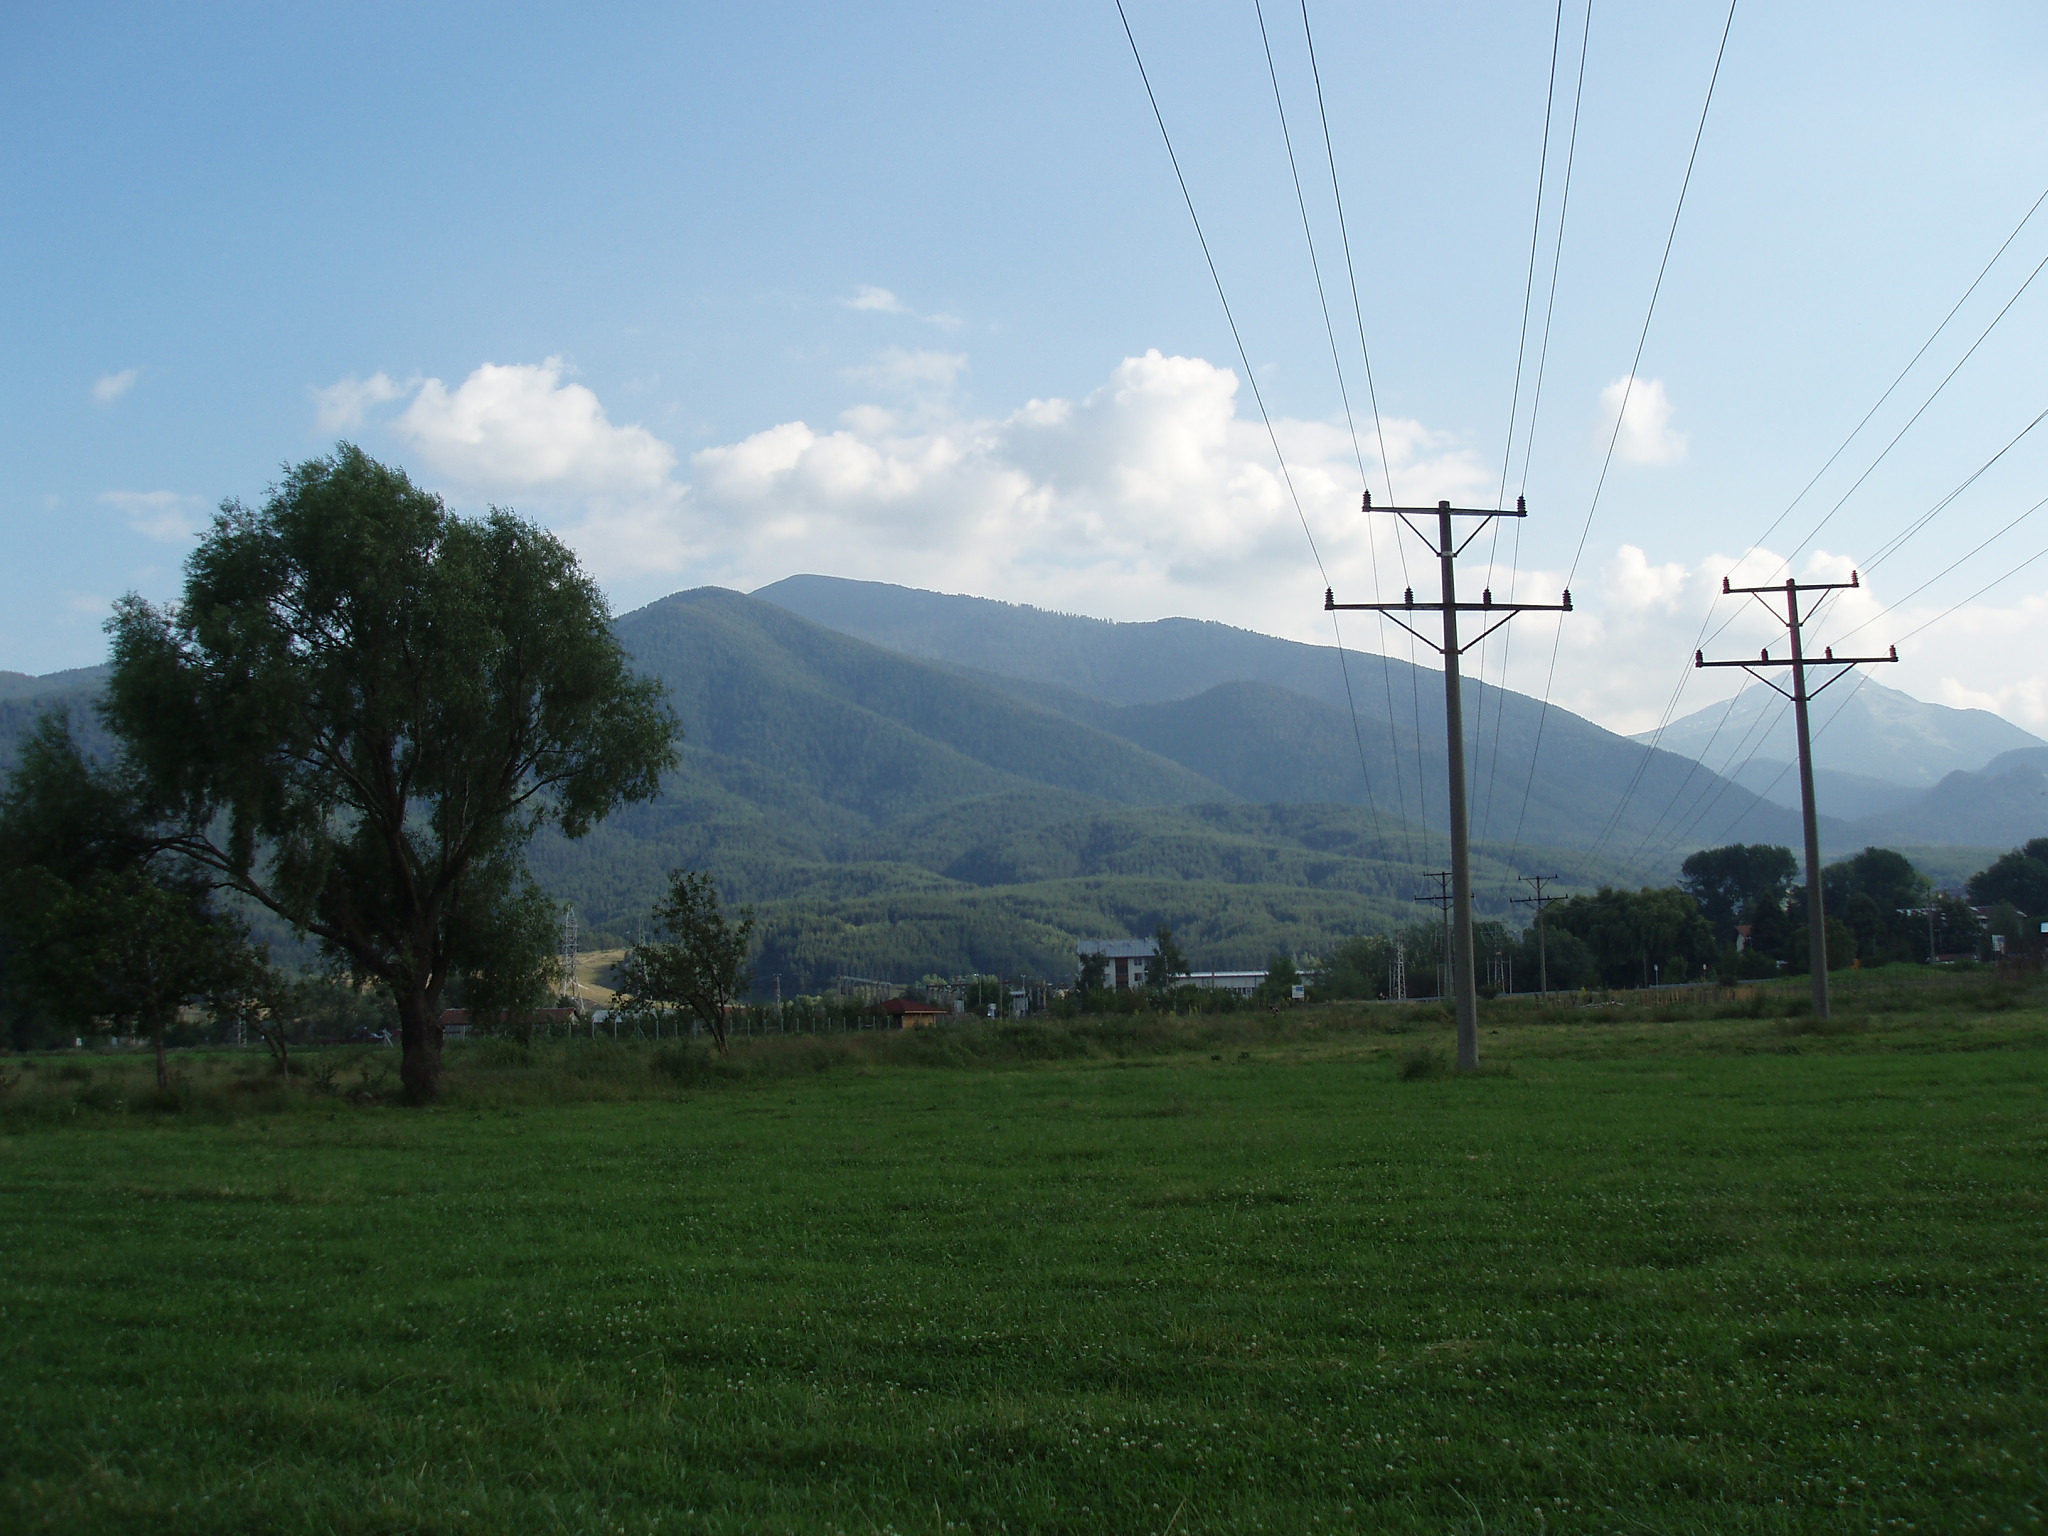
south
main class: Artificial land
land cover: Other artificial areas
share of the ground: > 75 %
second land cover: Grassland without tree/shrub cover
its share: > 75 %
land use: Electricity, gas and thermal power distribution
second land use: Agriculture (excluding fallow land and kitchen gardens)
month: July
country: BG
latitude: 41.8366
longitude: 23.5030
